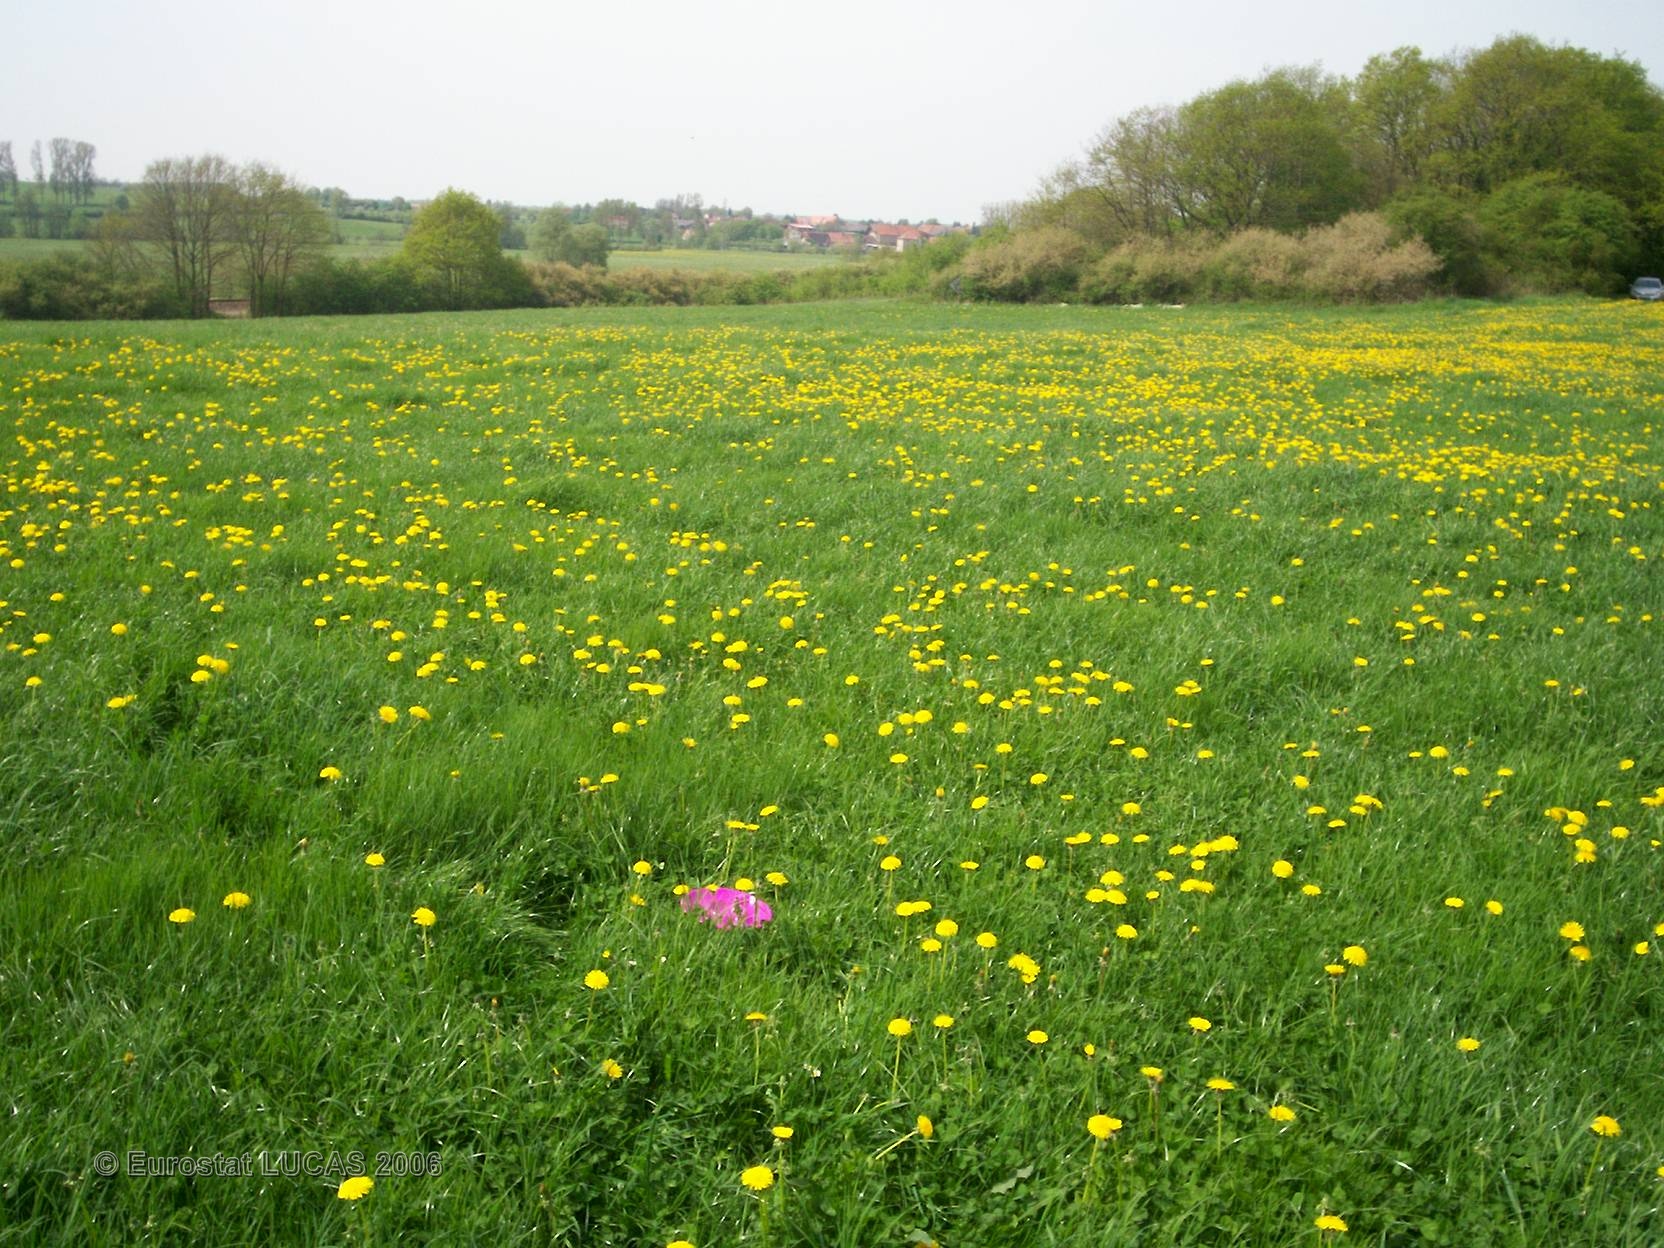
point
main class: Grassland
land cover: Grassland without tree/shrub cover
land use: Agriculture (excluding fallow land and kitchen gardens)
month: May
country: FR
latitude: 48.9407
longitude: 7.0652
